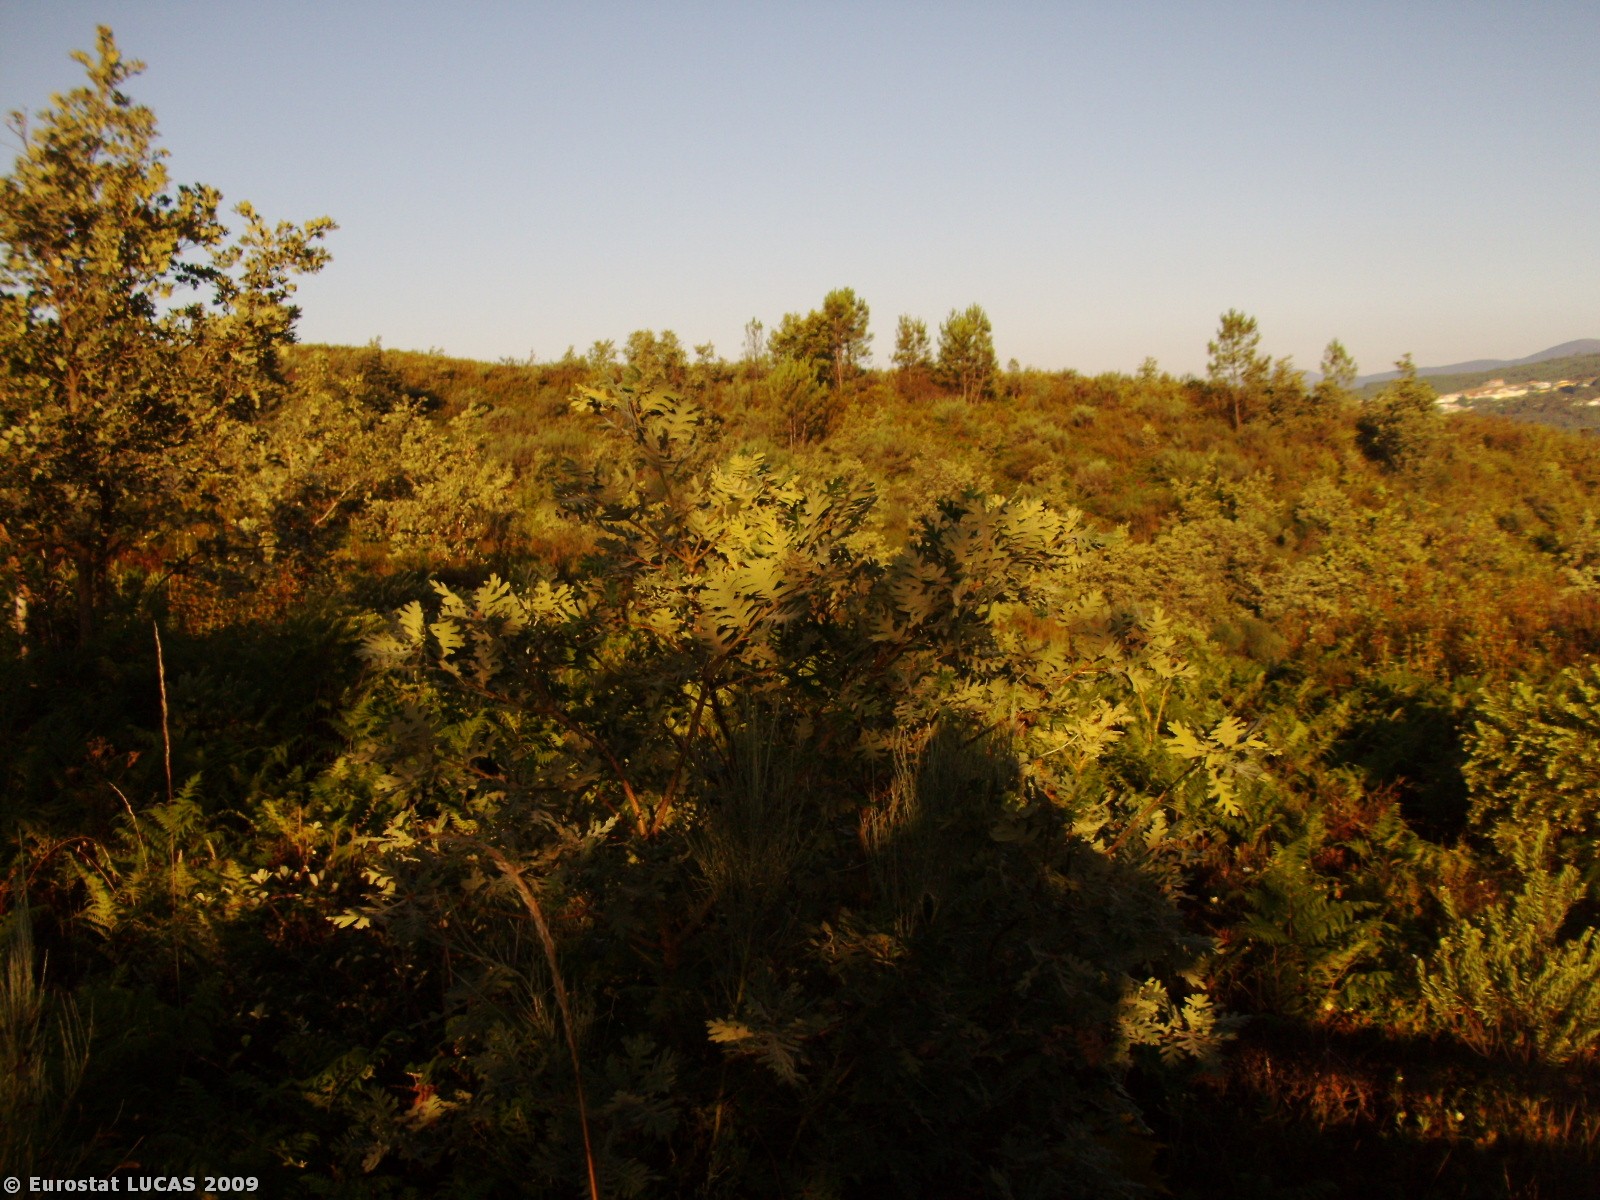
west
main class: Woodland
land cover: Mixed woodland
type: coniferous forest of the mediterranean region
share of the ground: 25 - 50 %
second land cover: Shrubland with sparse tree cover
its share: 50 - 75 %
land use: Forestry
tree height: > 5 m
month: July
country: PT
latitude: 40.2113
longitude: -7.5073
